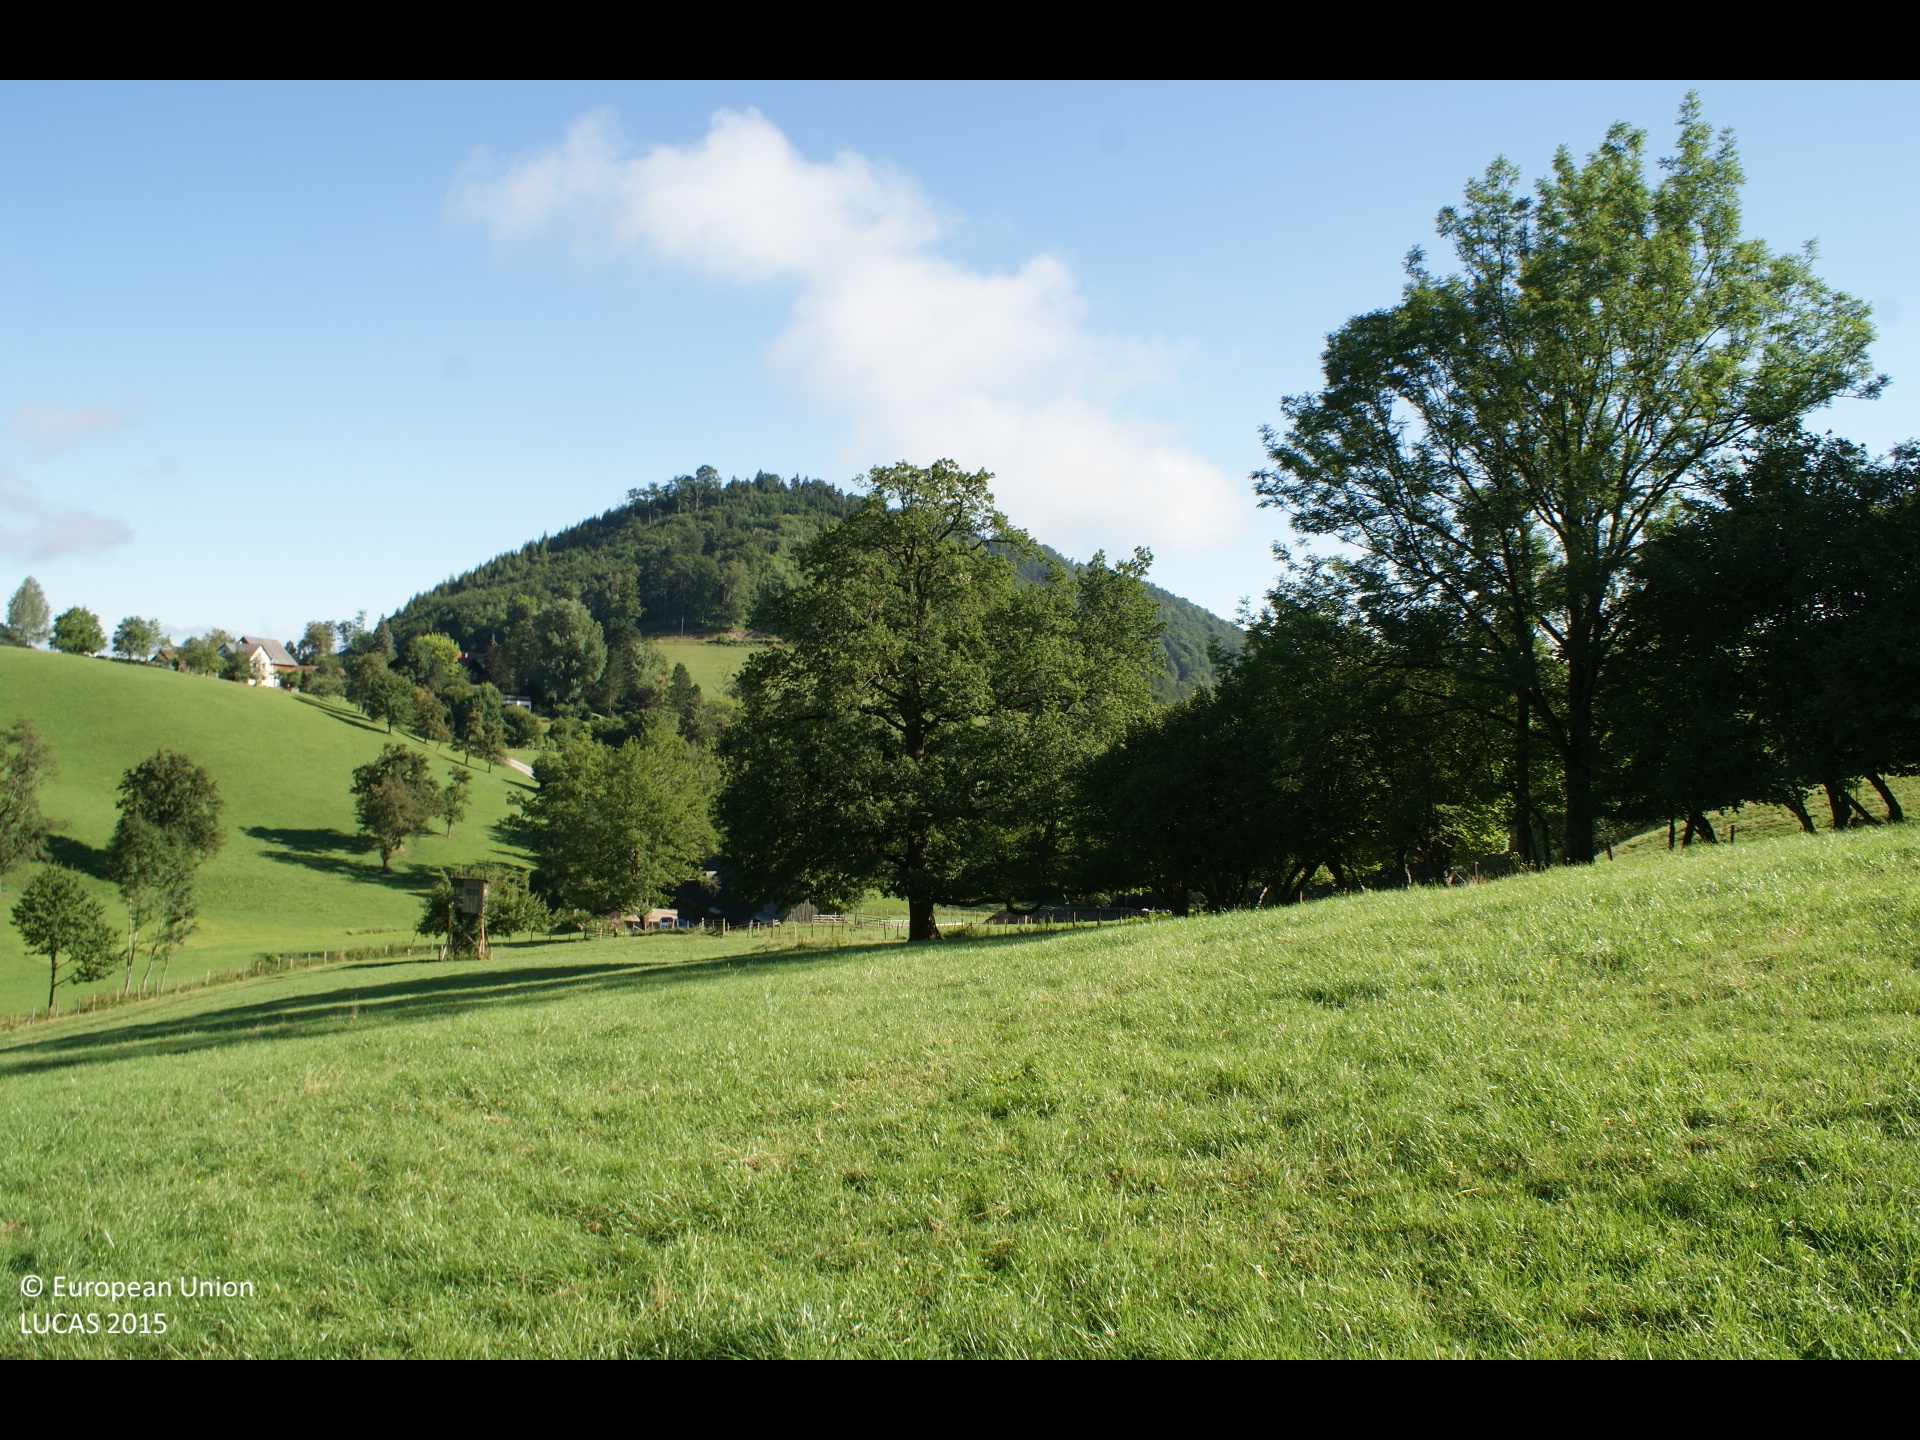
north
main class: Grassland
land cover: Grassland without tree/shrub cover
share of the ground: > 75 %
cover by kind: herbaceous plants 100 %
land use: Agriculture (excluding fallow land and kitchen gardens)
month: August
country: AT
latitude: 47.9205
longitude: 14.8045
